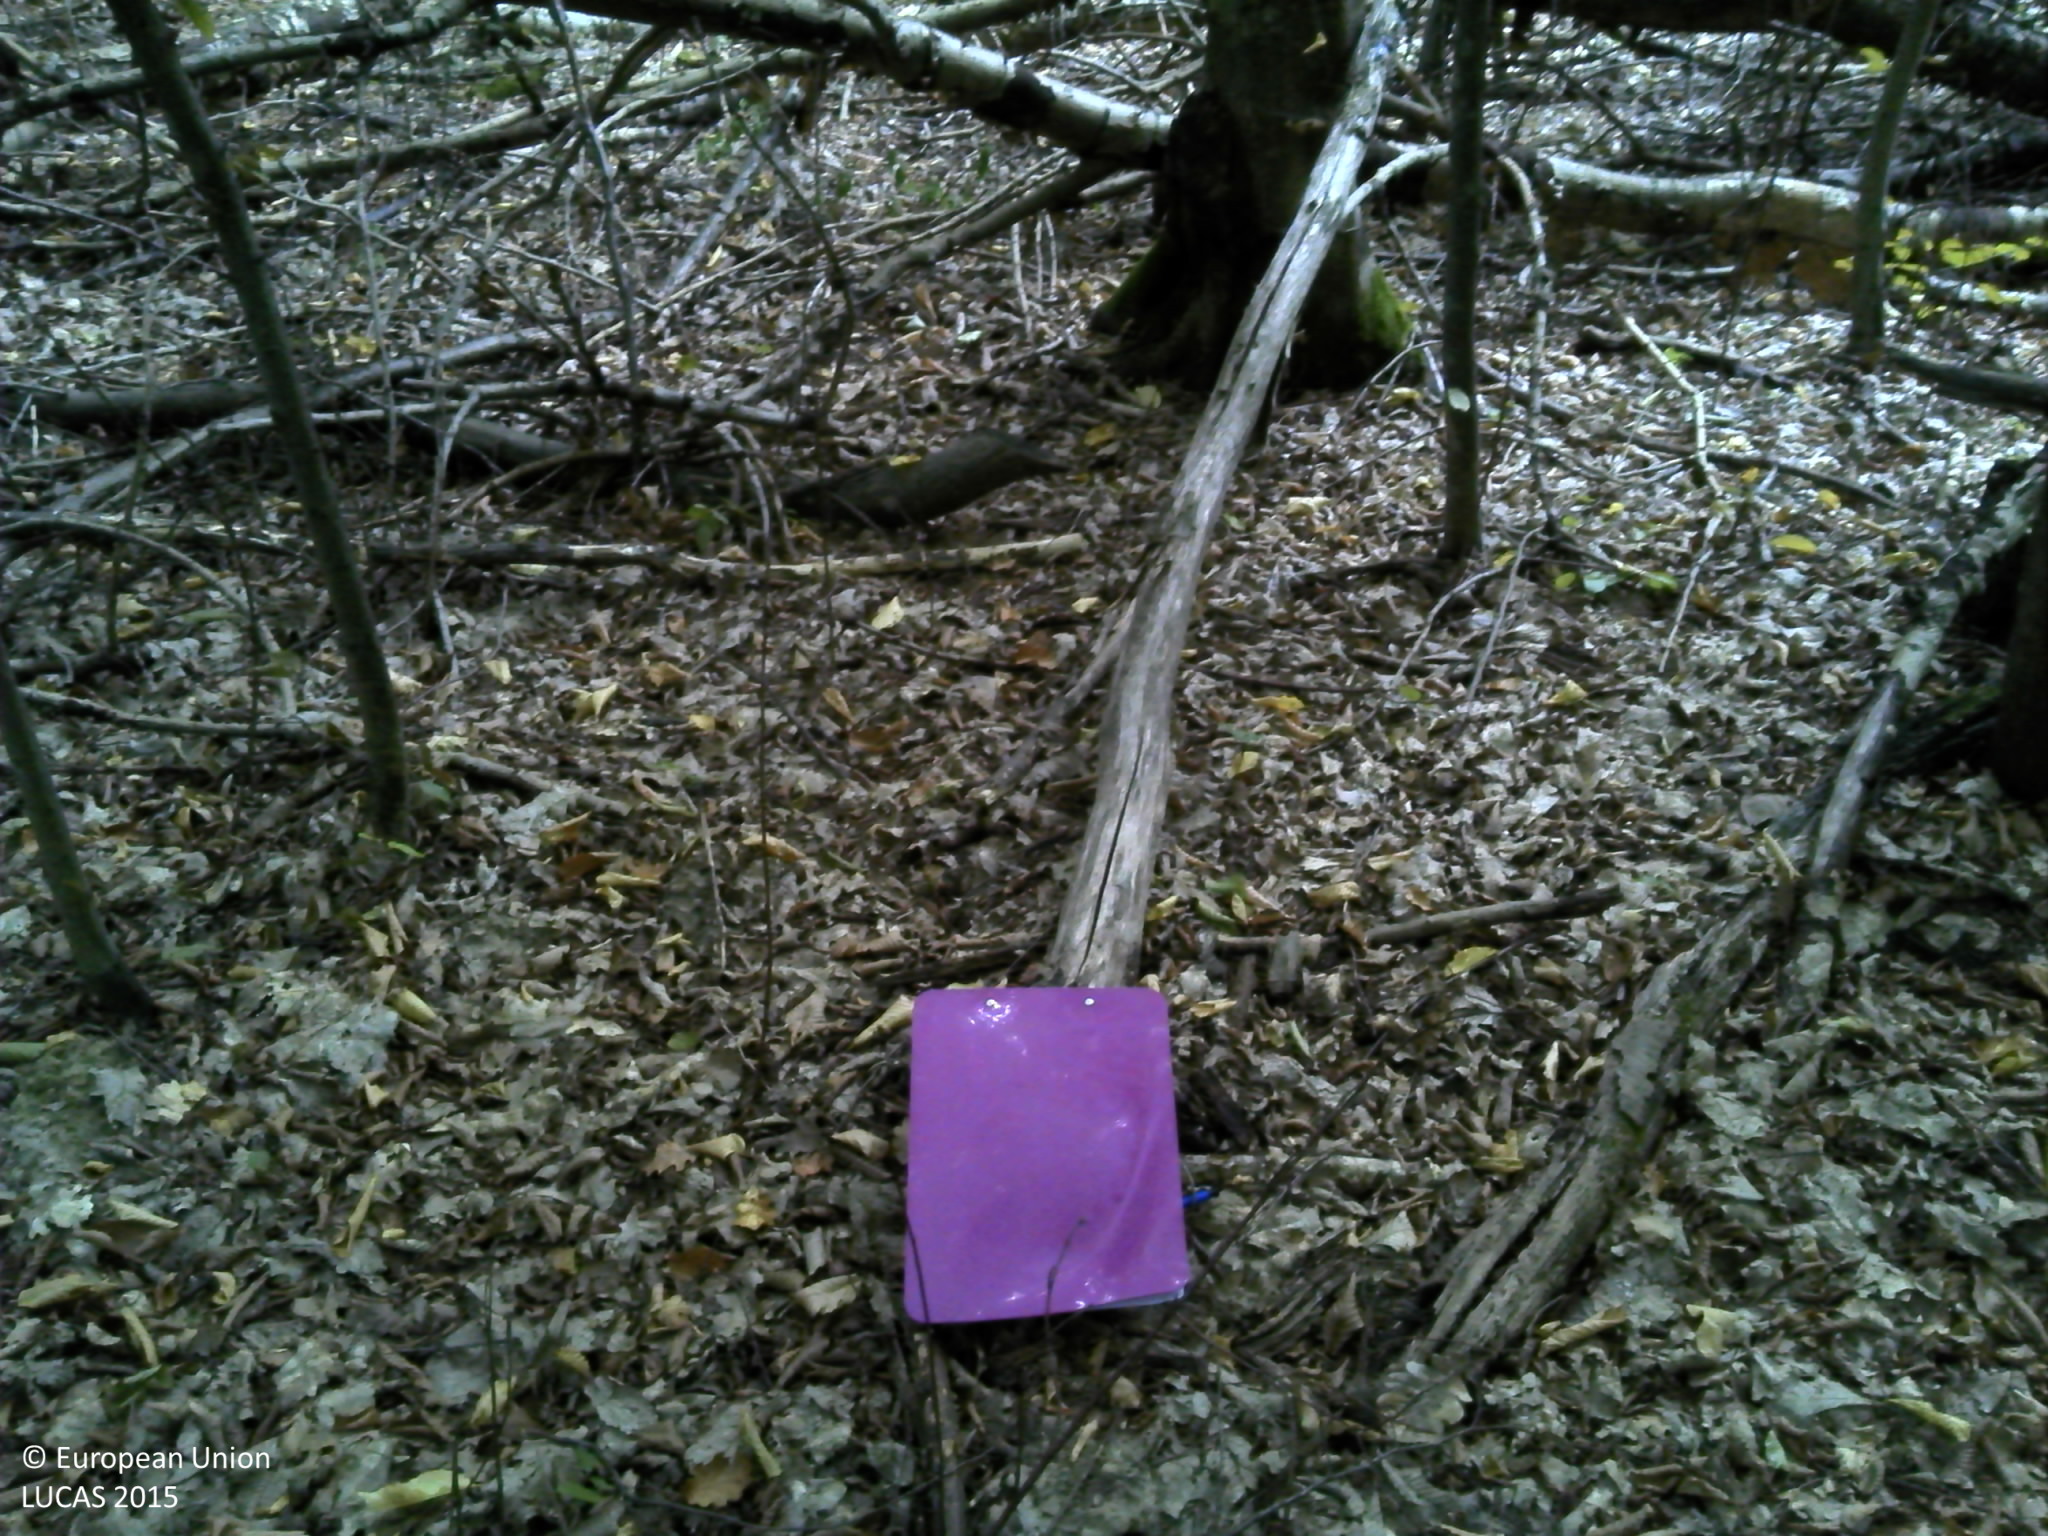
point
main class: Woodland
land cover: Broadleaved woodland
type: acidophilous oak and oak-birch forest
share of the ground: > 75 %
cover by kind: broadleaved forest trees 100 %
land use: Forestry
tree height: > 5 m
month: August
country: HR
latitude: 45.4920
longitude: 17.9754
